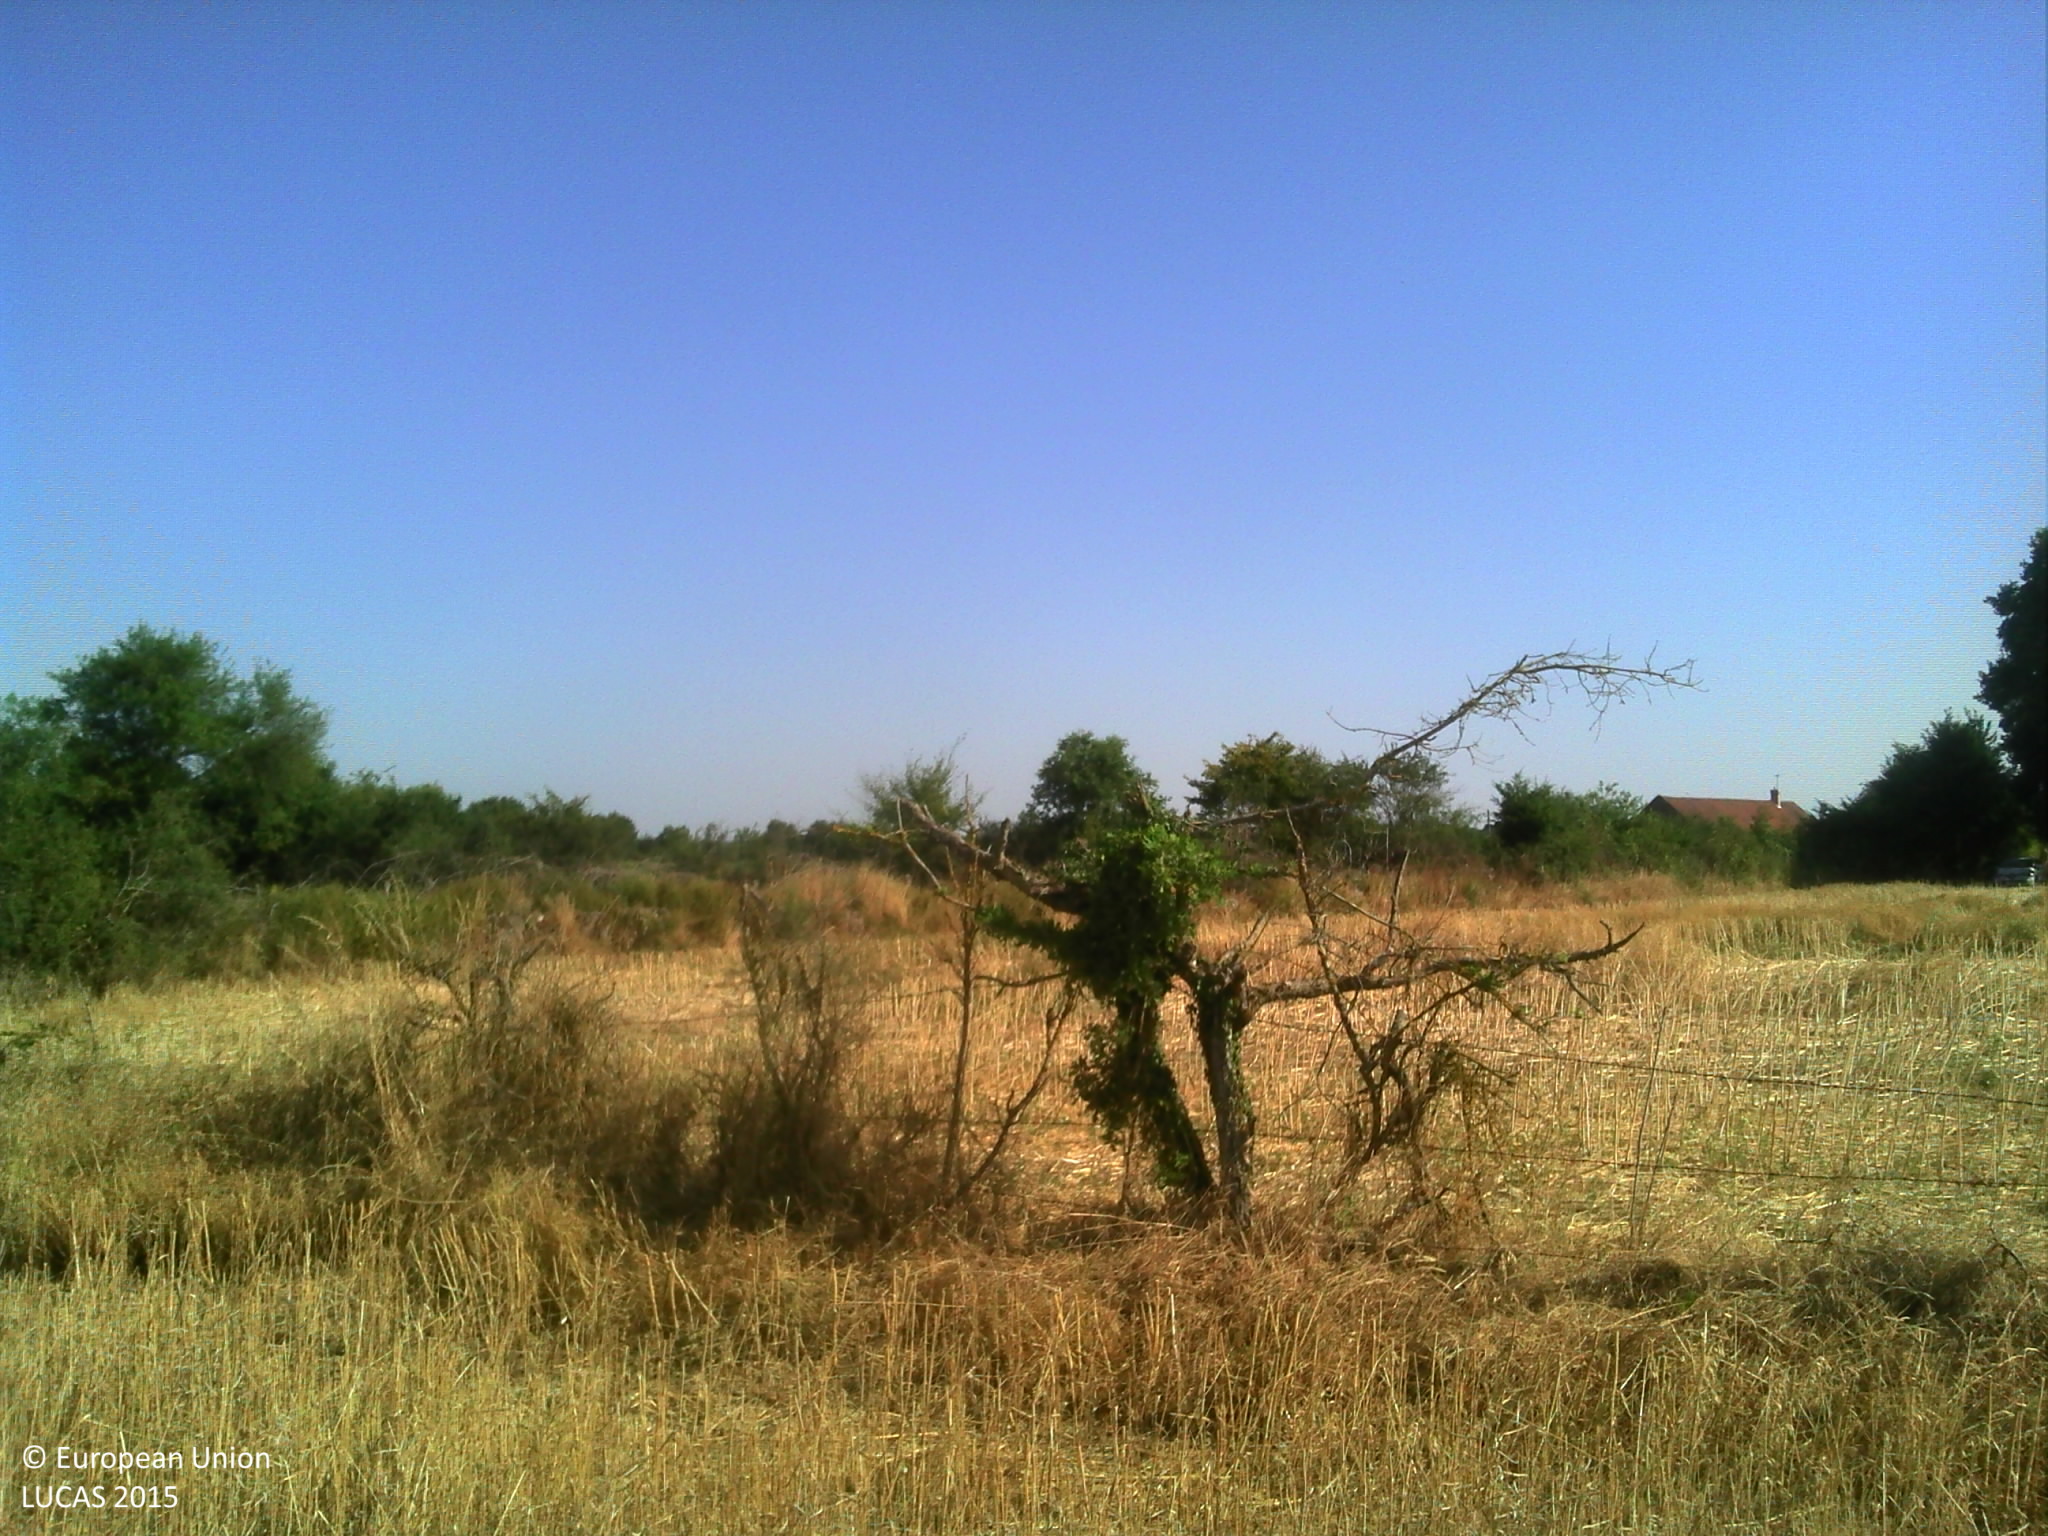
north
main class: Cropland
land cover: Rape and turnip rape
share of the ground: > 75 %
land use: Agriculture (excluding fallow land and kitchen gardens)
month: July
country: FR
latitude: 46.7630
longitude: 5.1179
